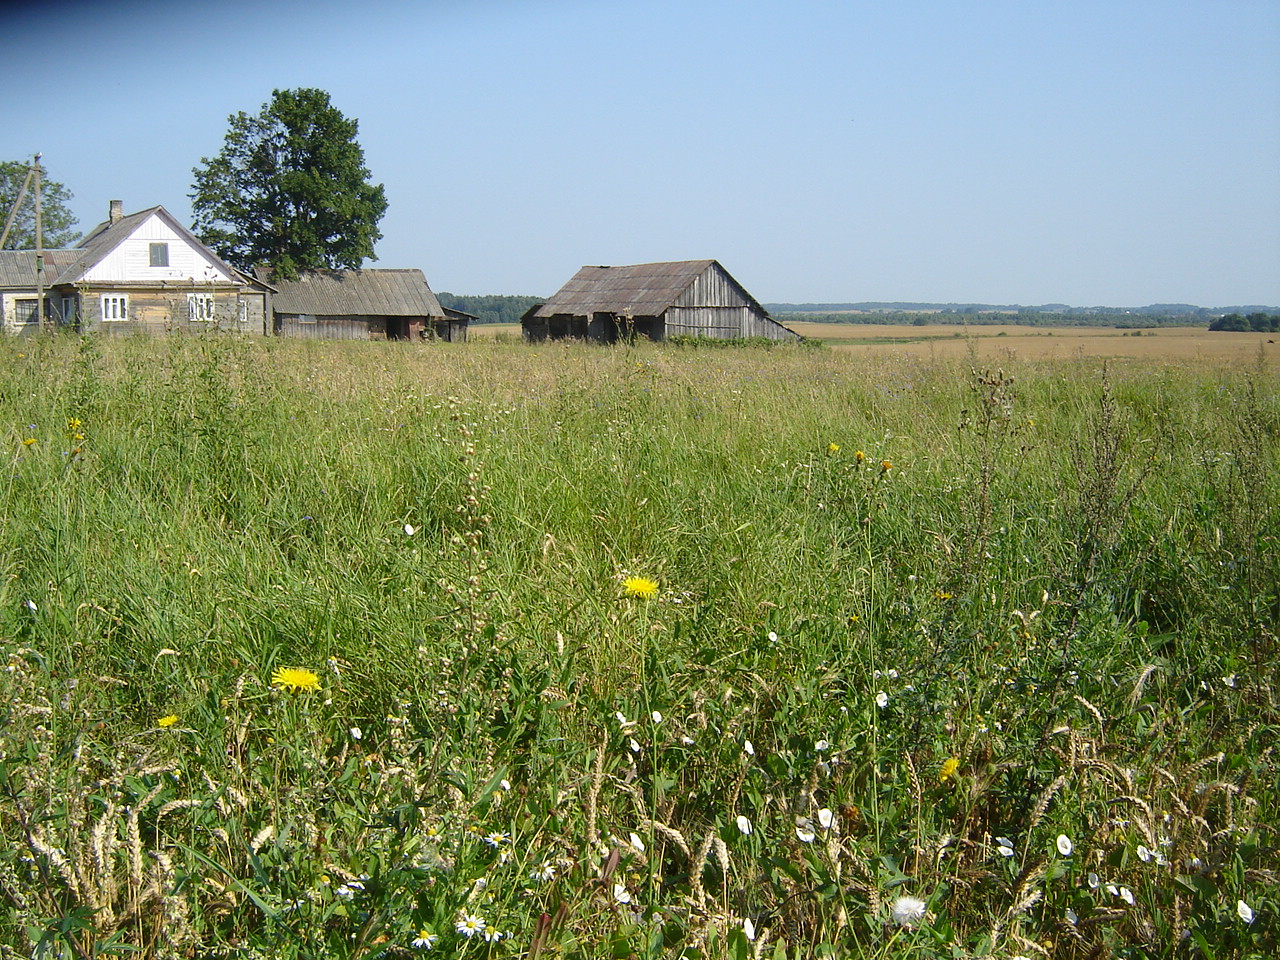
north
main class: Cropland
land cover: Common wheat
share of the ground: > 75 %
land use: Agriculture (excluding fallow land and kitchen gardens)
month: August
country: LT
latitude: 55.1191
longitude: 25.1214
